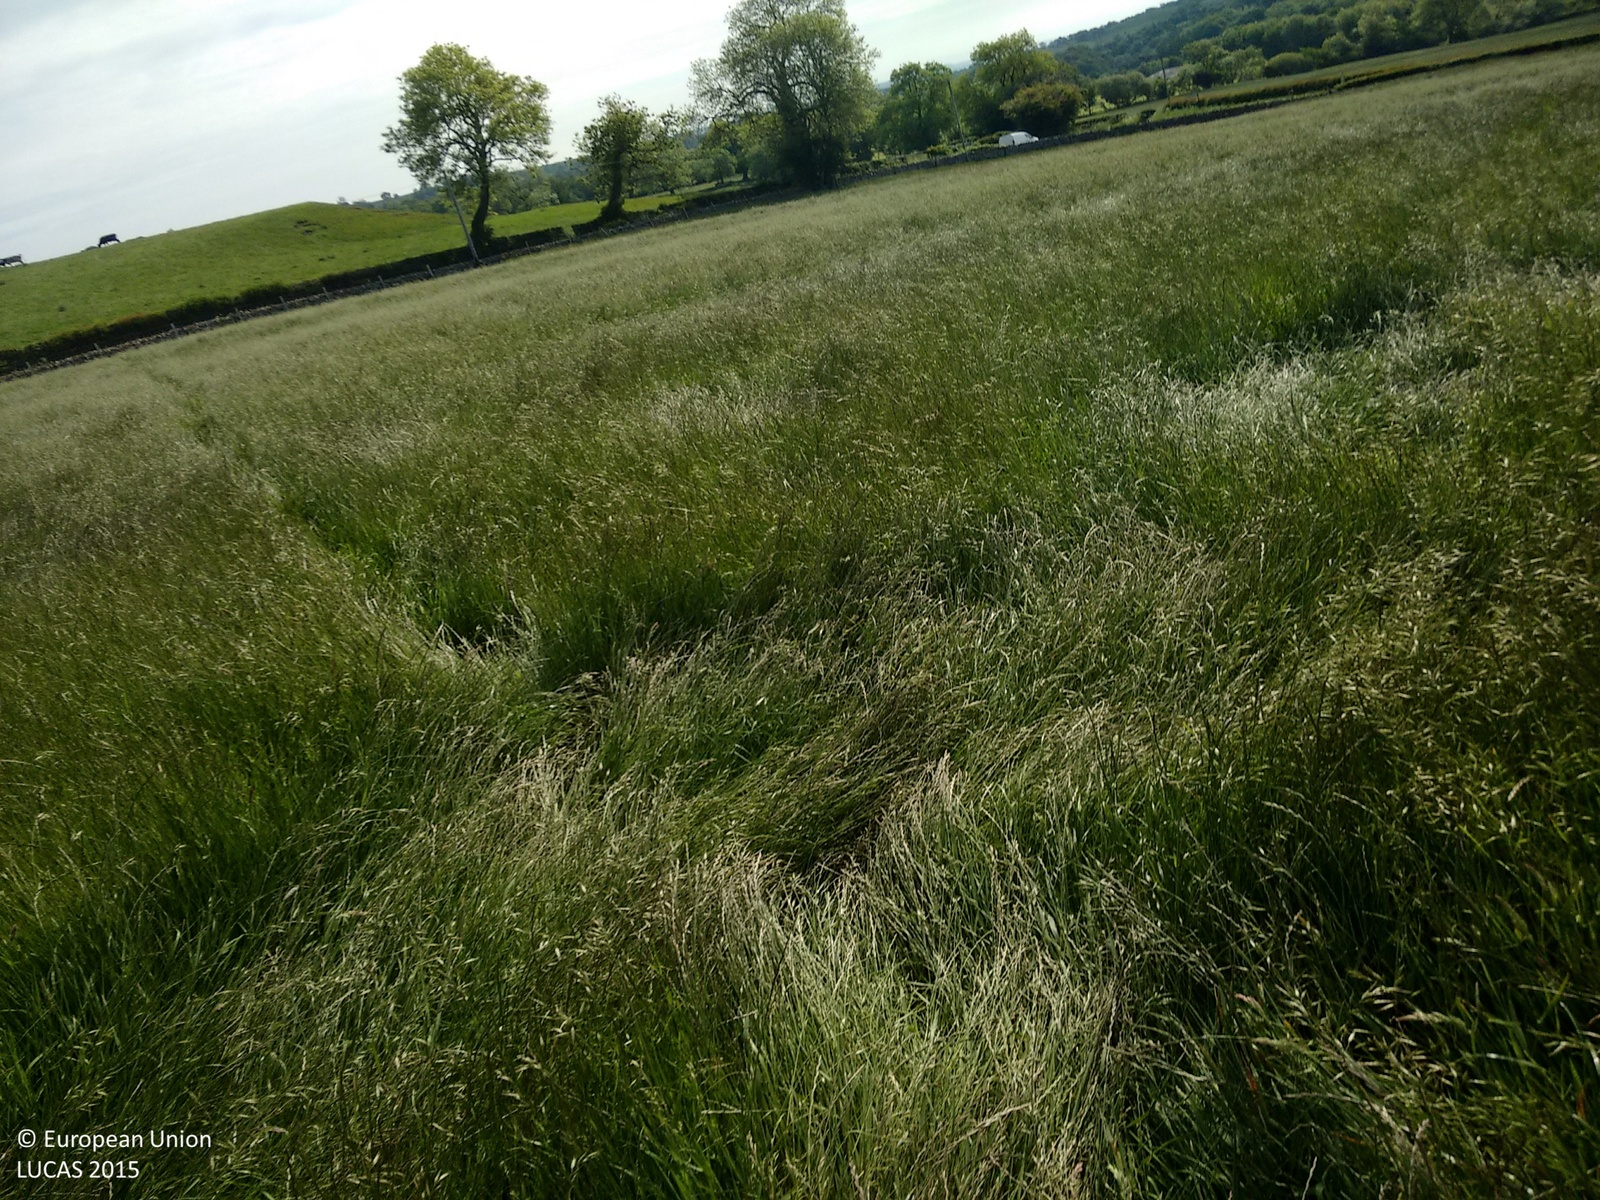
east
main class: Grassland
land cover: Grassland without tree/shrub cover
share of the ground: > 75 %
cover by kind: herbaceous plants 100 %
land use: Agriculture (excluding fallow land and kitchen gardens)
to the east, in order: Grassland without tree/shrub cover; Fences; Dry stone walls; Grassland without tree/shrub cover; Paved roads, cycling and walking lanes; Grass margins; Paved roads, cycling and walking lanes; Grass margins; Managed hedges; Fences; Grassland without tree/shrub cover
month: June
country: GB
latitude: 54.2710
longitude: -1.8626
